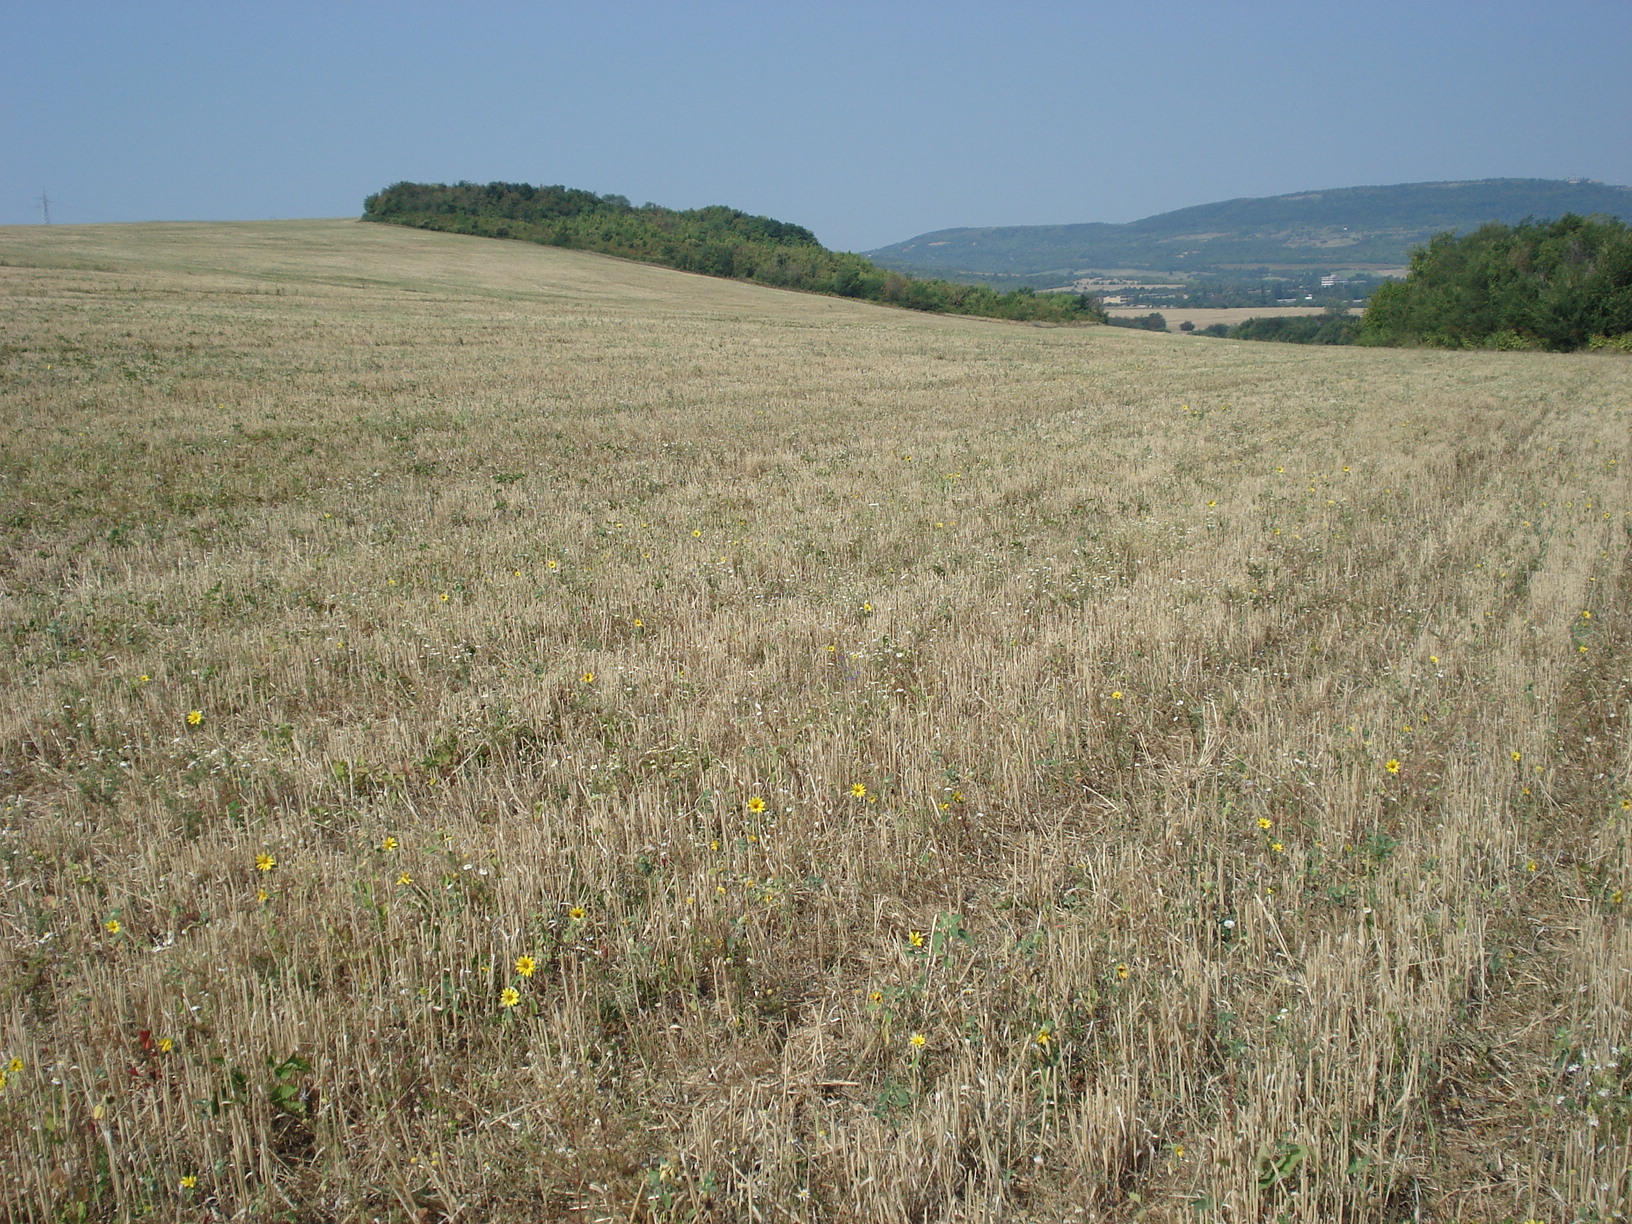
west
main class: Cropland
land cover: Common wheat
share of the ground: 50 - 75 %
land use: Agriculture (excluding fallow land and kitchen gardens)
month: August
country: BG
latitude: 43.0808
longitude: 25.7679
